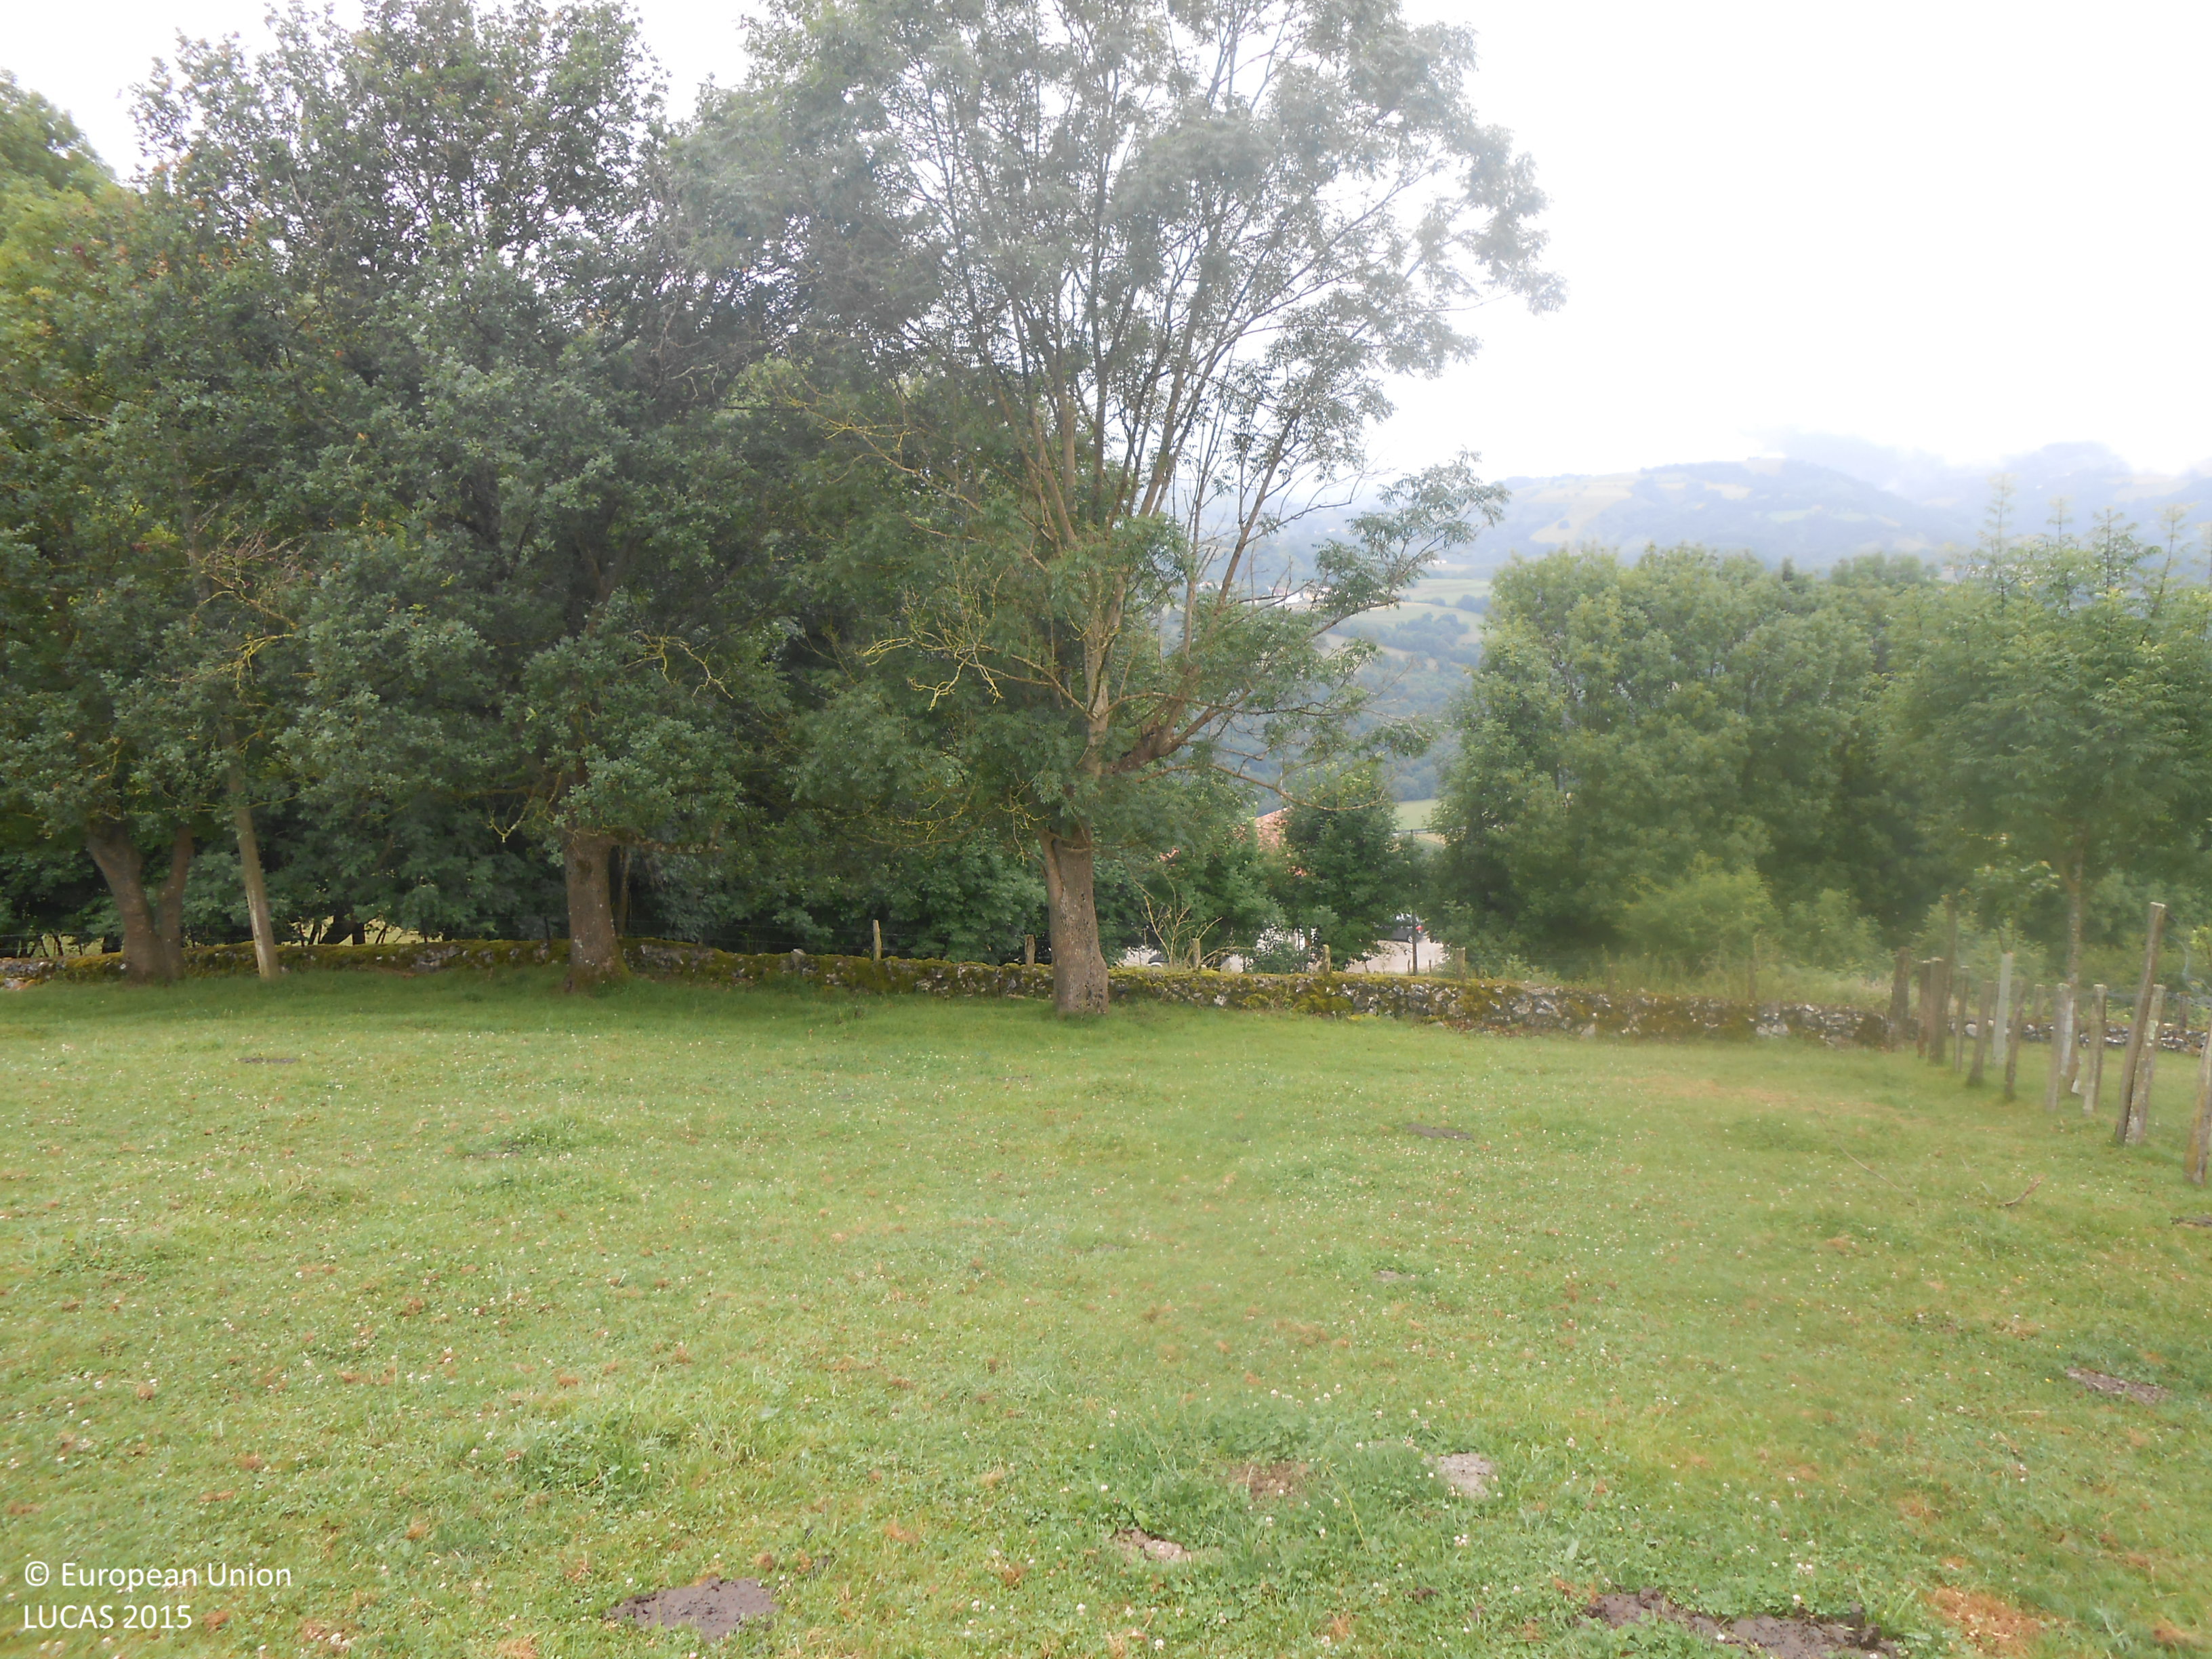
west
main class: Grassland
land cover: Grassland without tree/shrub cover
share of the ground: > 75 %
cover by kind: herbaceous plants 100 %
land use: Agriculture (excluding fallow land and kitchen gardens)
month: June
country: ES
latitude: 43.1226
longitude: -1.5328
